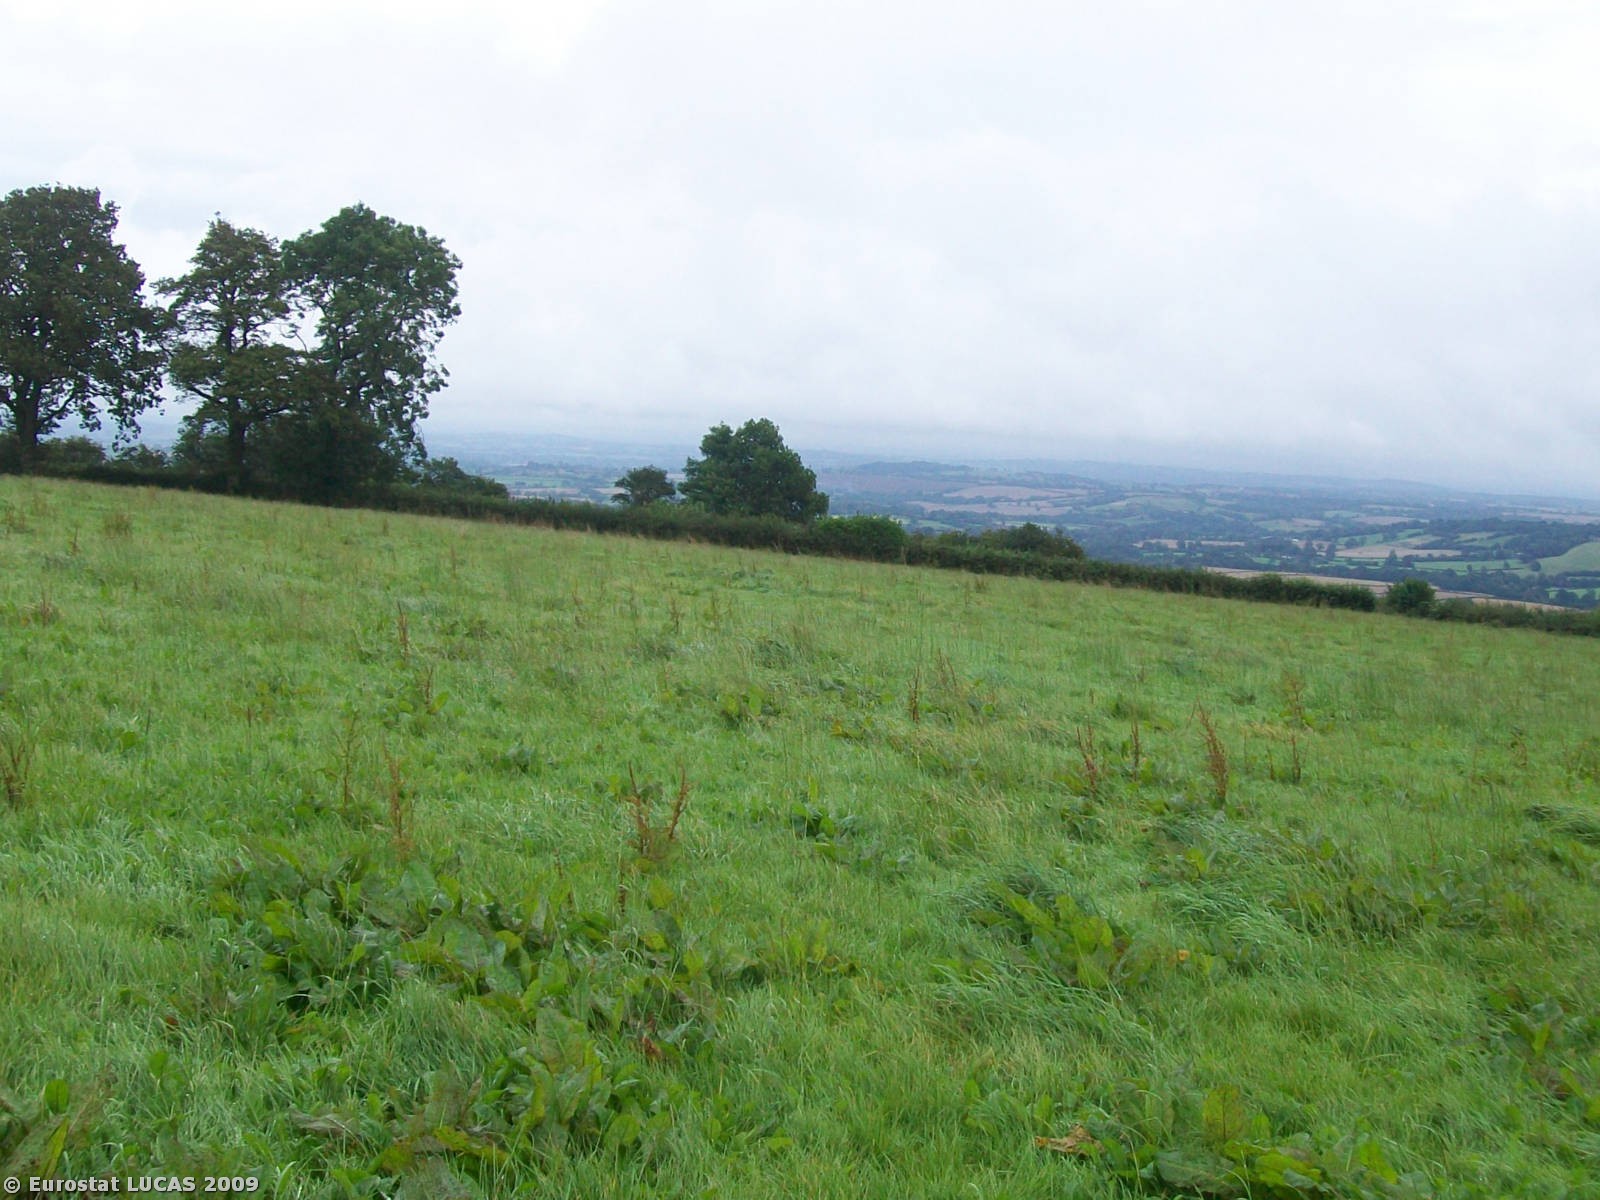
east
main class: Grassland
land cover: Grassland without tree/shrub cover
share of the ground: > 75 %
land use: Agriculture (excluding fallow land and kitchen gardens)
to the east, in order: Grassland without tree/shrub cover; Managed hedges; Grass margins; Tracks; Grass margins; Managed hedges; Grassland without tree/shrub cover; Lines of trees; Fences; Grassland without tree/shrub cover
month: September
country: GB
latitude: 52.4326
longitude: -2.5845
